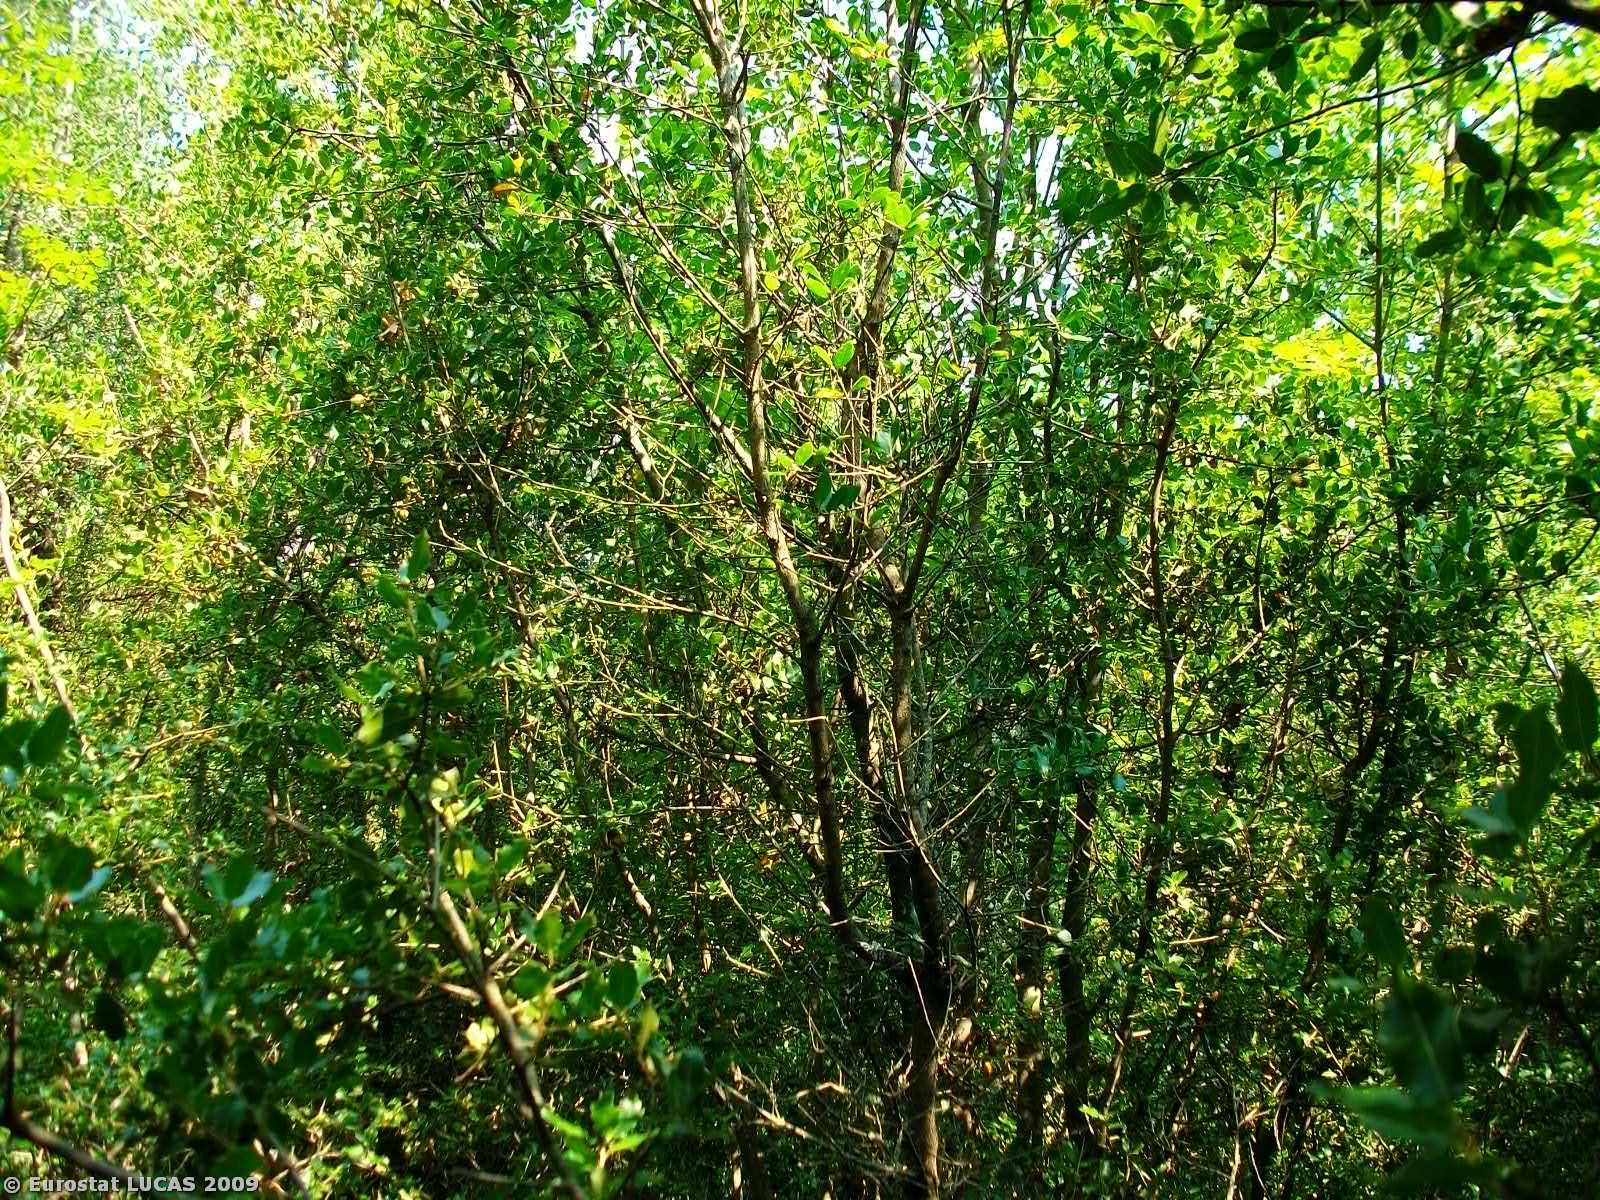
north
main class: Woodland
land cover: Broadleaved woodland
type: mesophytic deciduous forest
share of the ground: > 75 %
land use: Forestry
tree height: > 5 m
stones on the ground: 10 - 25 %
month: July
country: GR
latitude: 41.0560
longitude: 24.4904
